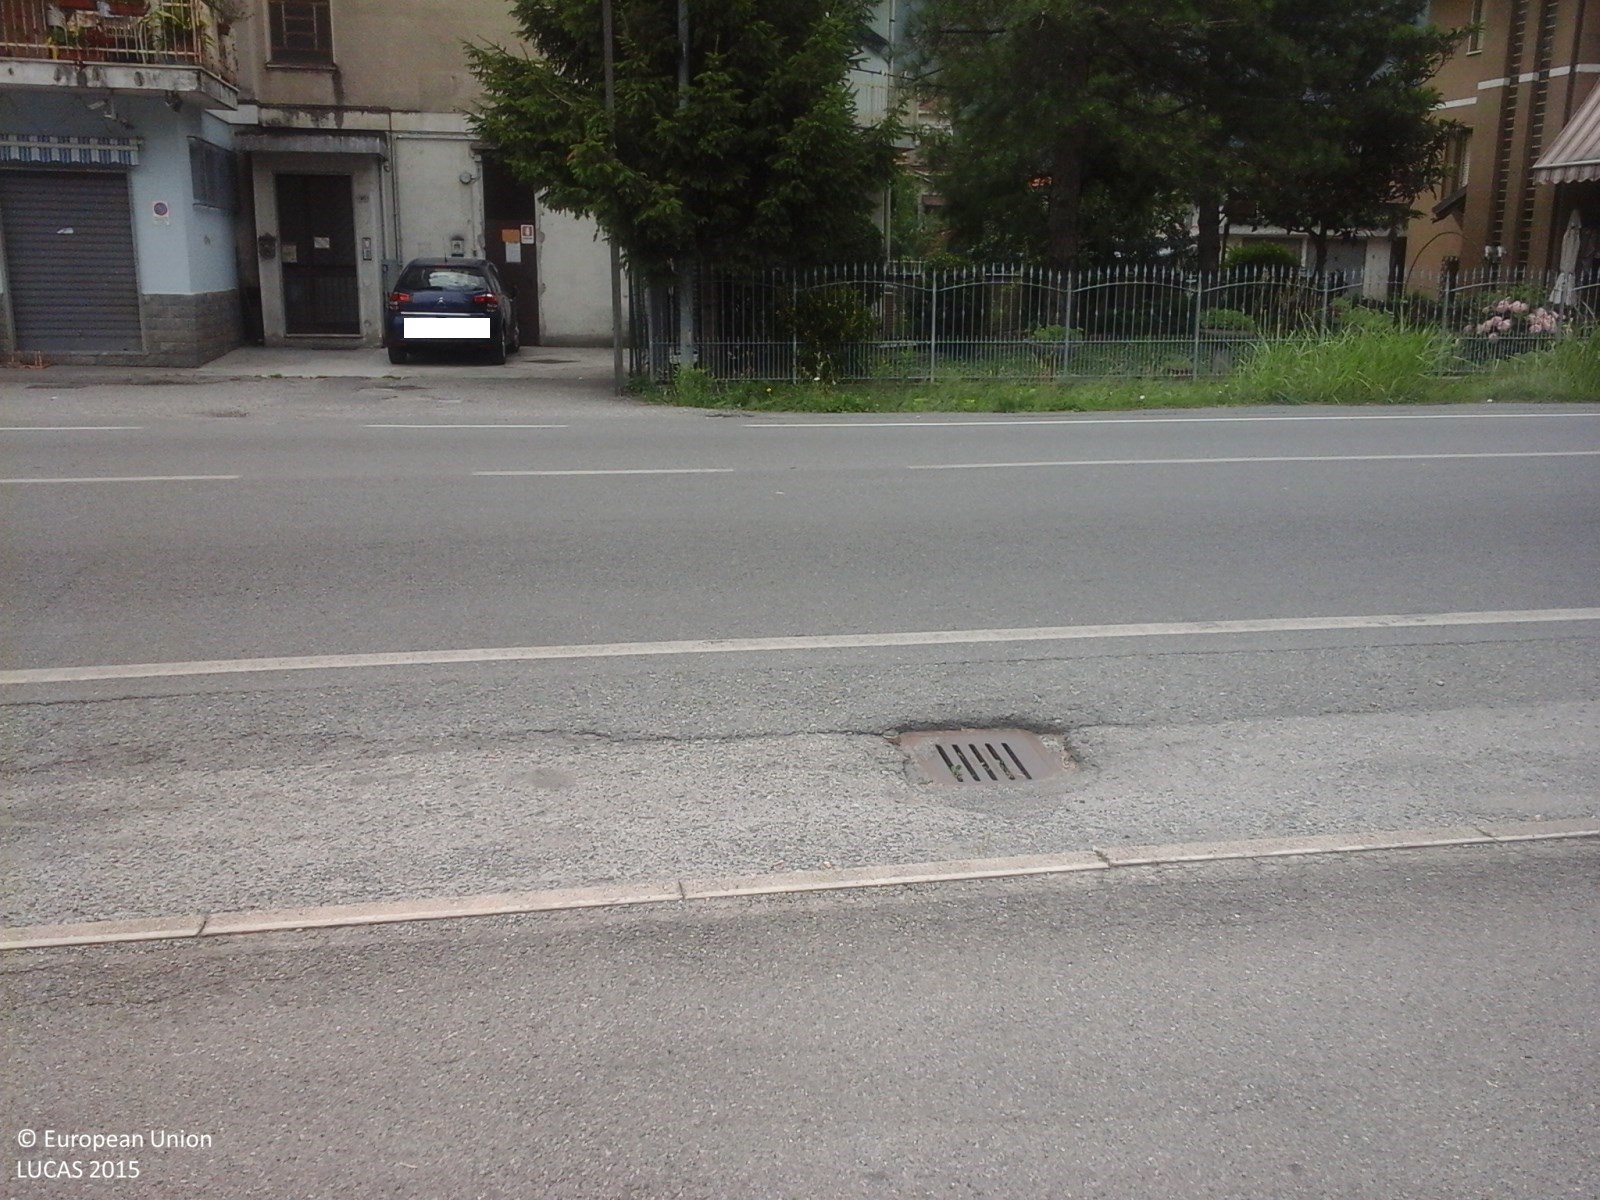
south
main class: Grassland
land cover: Grassland with sparse tree/shrub cover
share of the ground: > 75 %
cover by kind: herbaceous plants 90 %, broadleaved forest trees 5 %, shrubs 5 %
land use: Residential
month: July
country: IT
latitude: 45.1085
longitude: 7.2719
